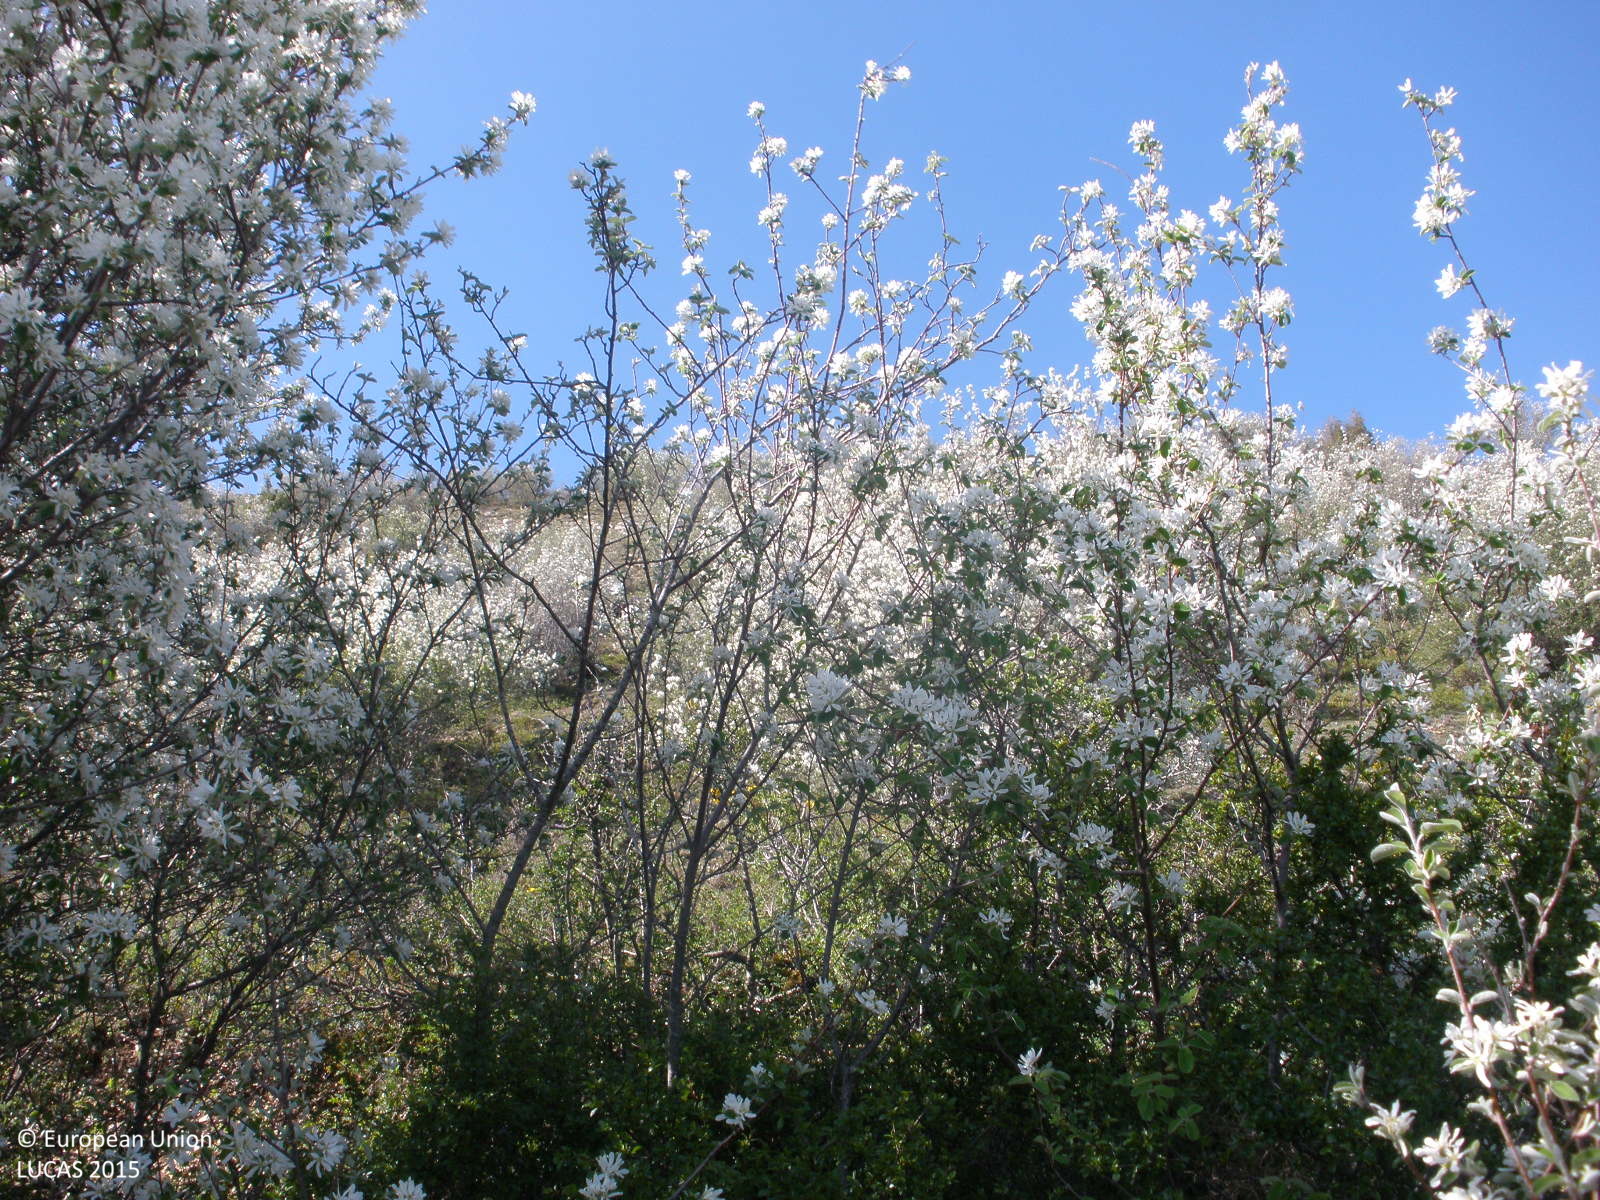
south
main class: Shrubland
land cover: Shrubland without tree cover
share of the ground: > 75 %
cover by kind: shrubs 70 %, herbaceous plants 30 %
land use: Agriculture (excluding fallow land and kitchen gardens)
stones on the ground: > 50 %
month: May
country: ES
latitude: 40.6504
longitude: -0.8329
